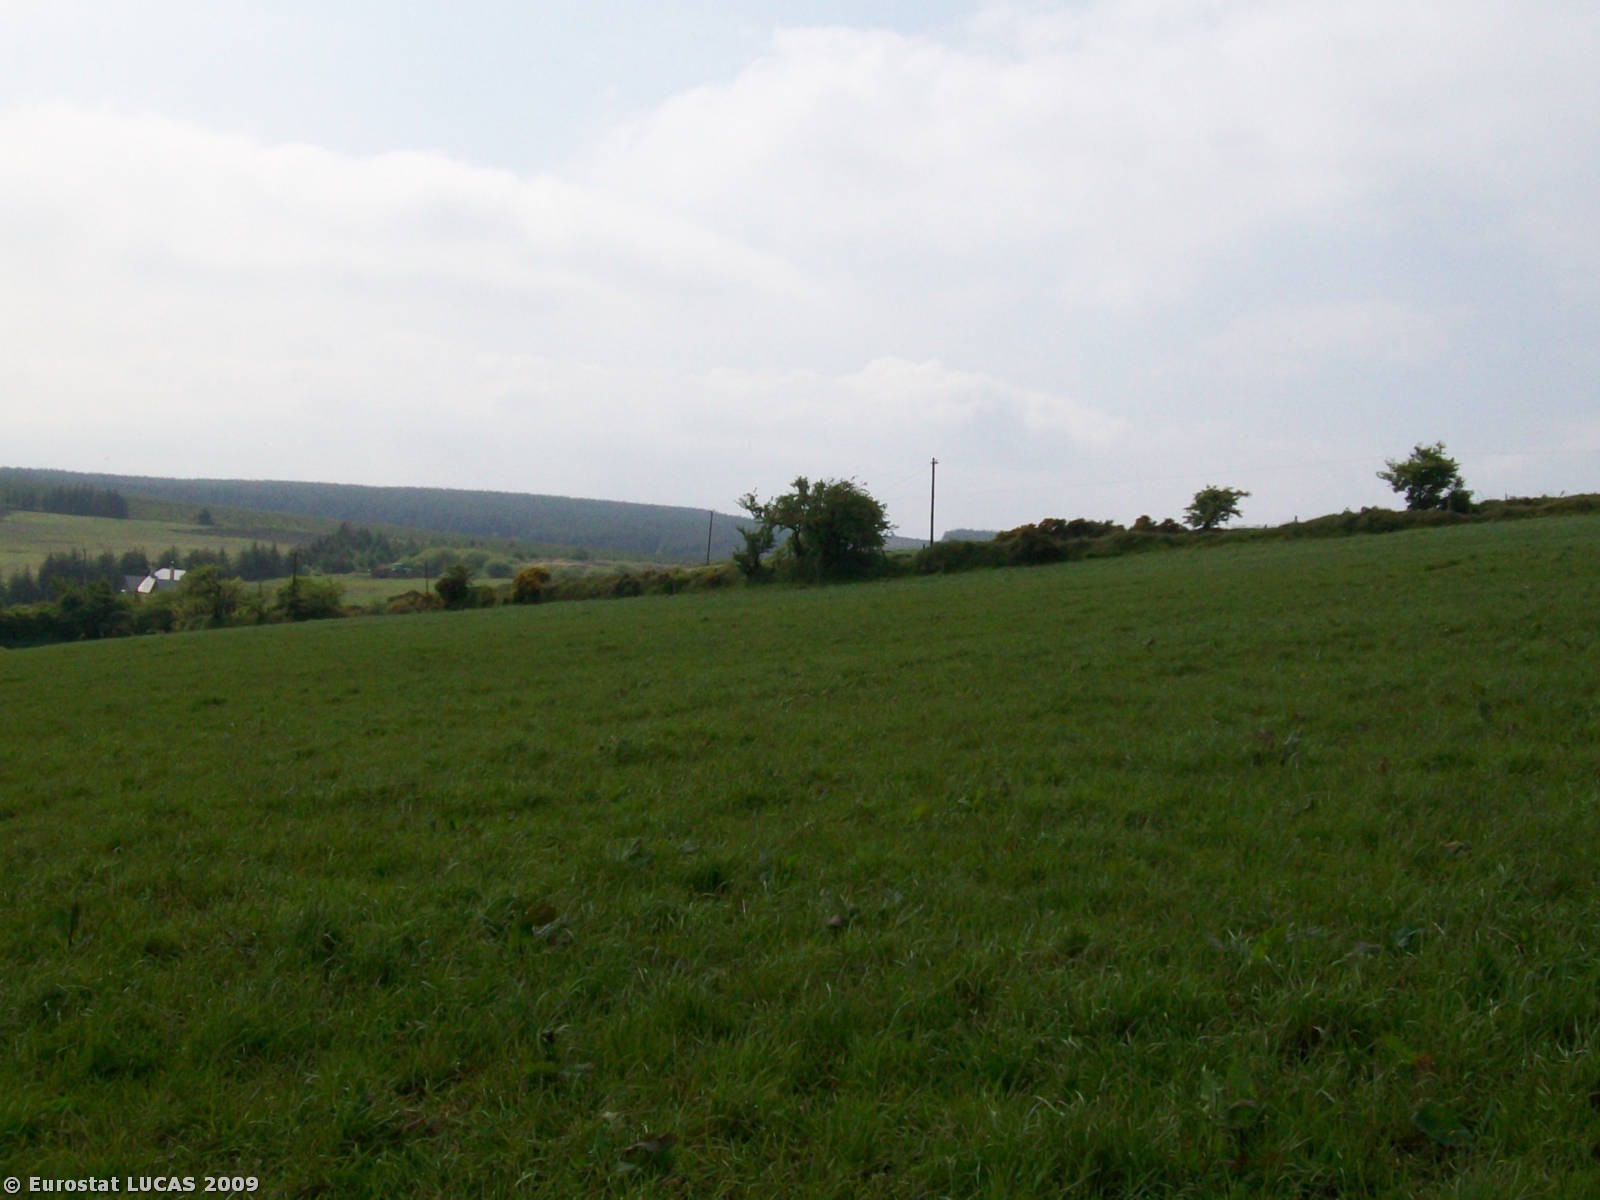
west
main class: Grassland
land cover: Grassland without tree/shrub cover
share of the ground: > 75 %
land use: Agriculture (excluding fallow land and kitchen gardens)
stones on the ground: < 10 %
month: May
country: IE
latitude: 52.0222
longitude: -8.7854
